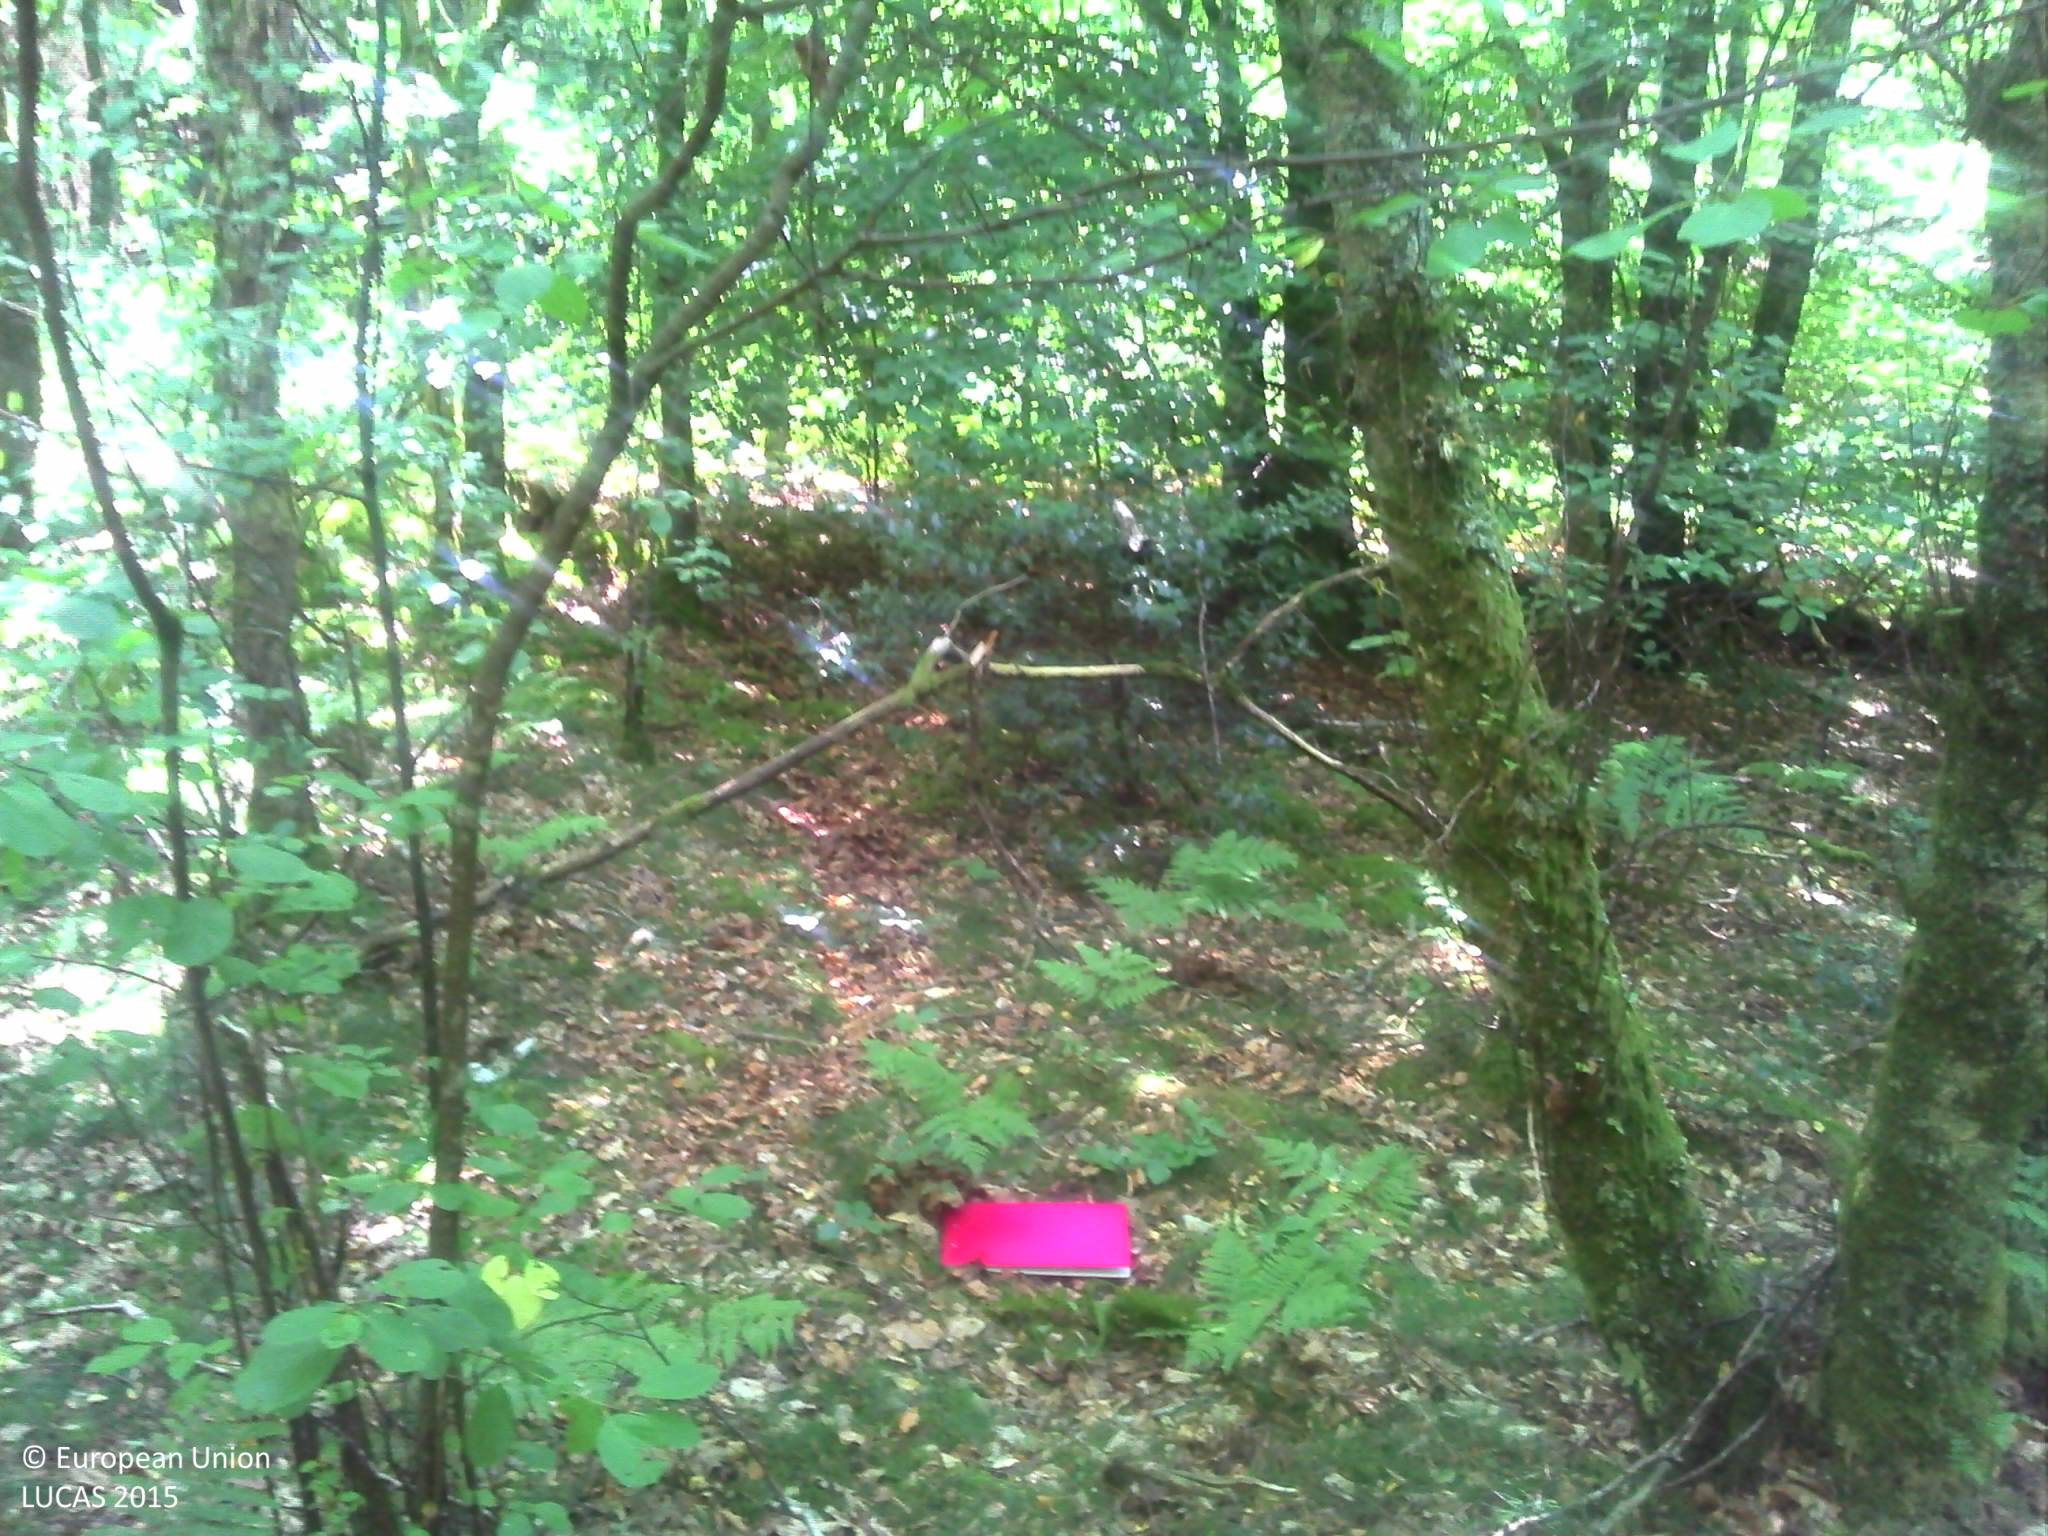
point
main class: Woodland
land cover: Broadleaved woodland
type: acidophilous oak and oak-birch forest
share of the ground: > 75 %
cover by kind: broadleaved forest trees 85 %, lichens and mosses 10 %, herbaceous plants 5 %
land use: Forestry
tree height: > 5 m
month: July
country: FR
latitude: 46.0548
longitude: 1.5775
